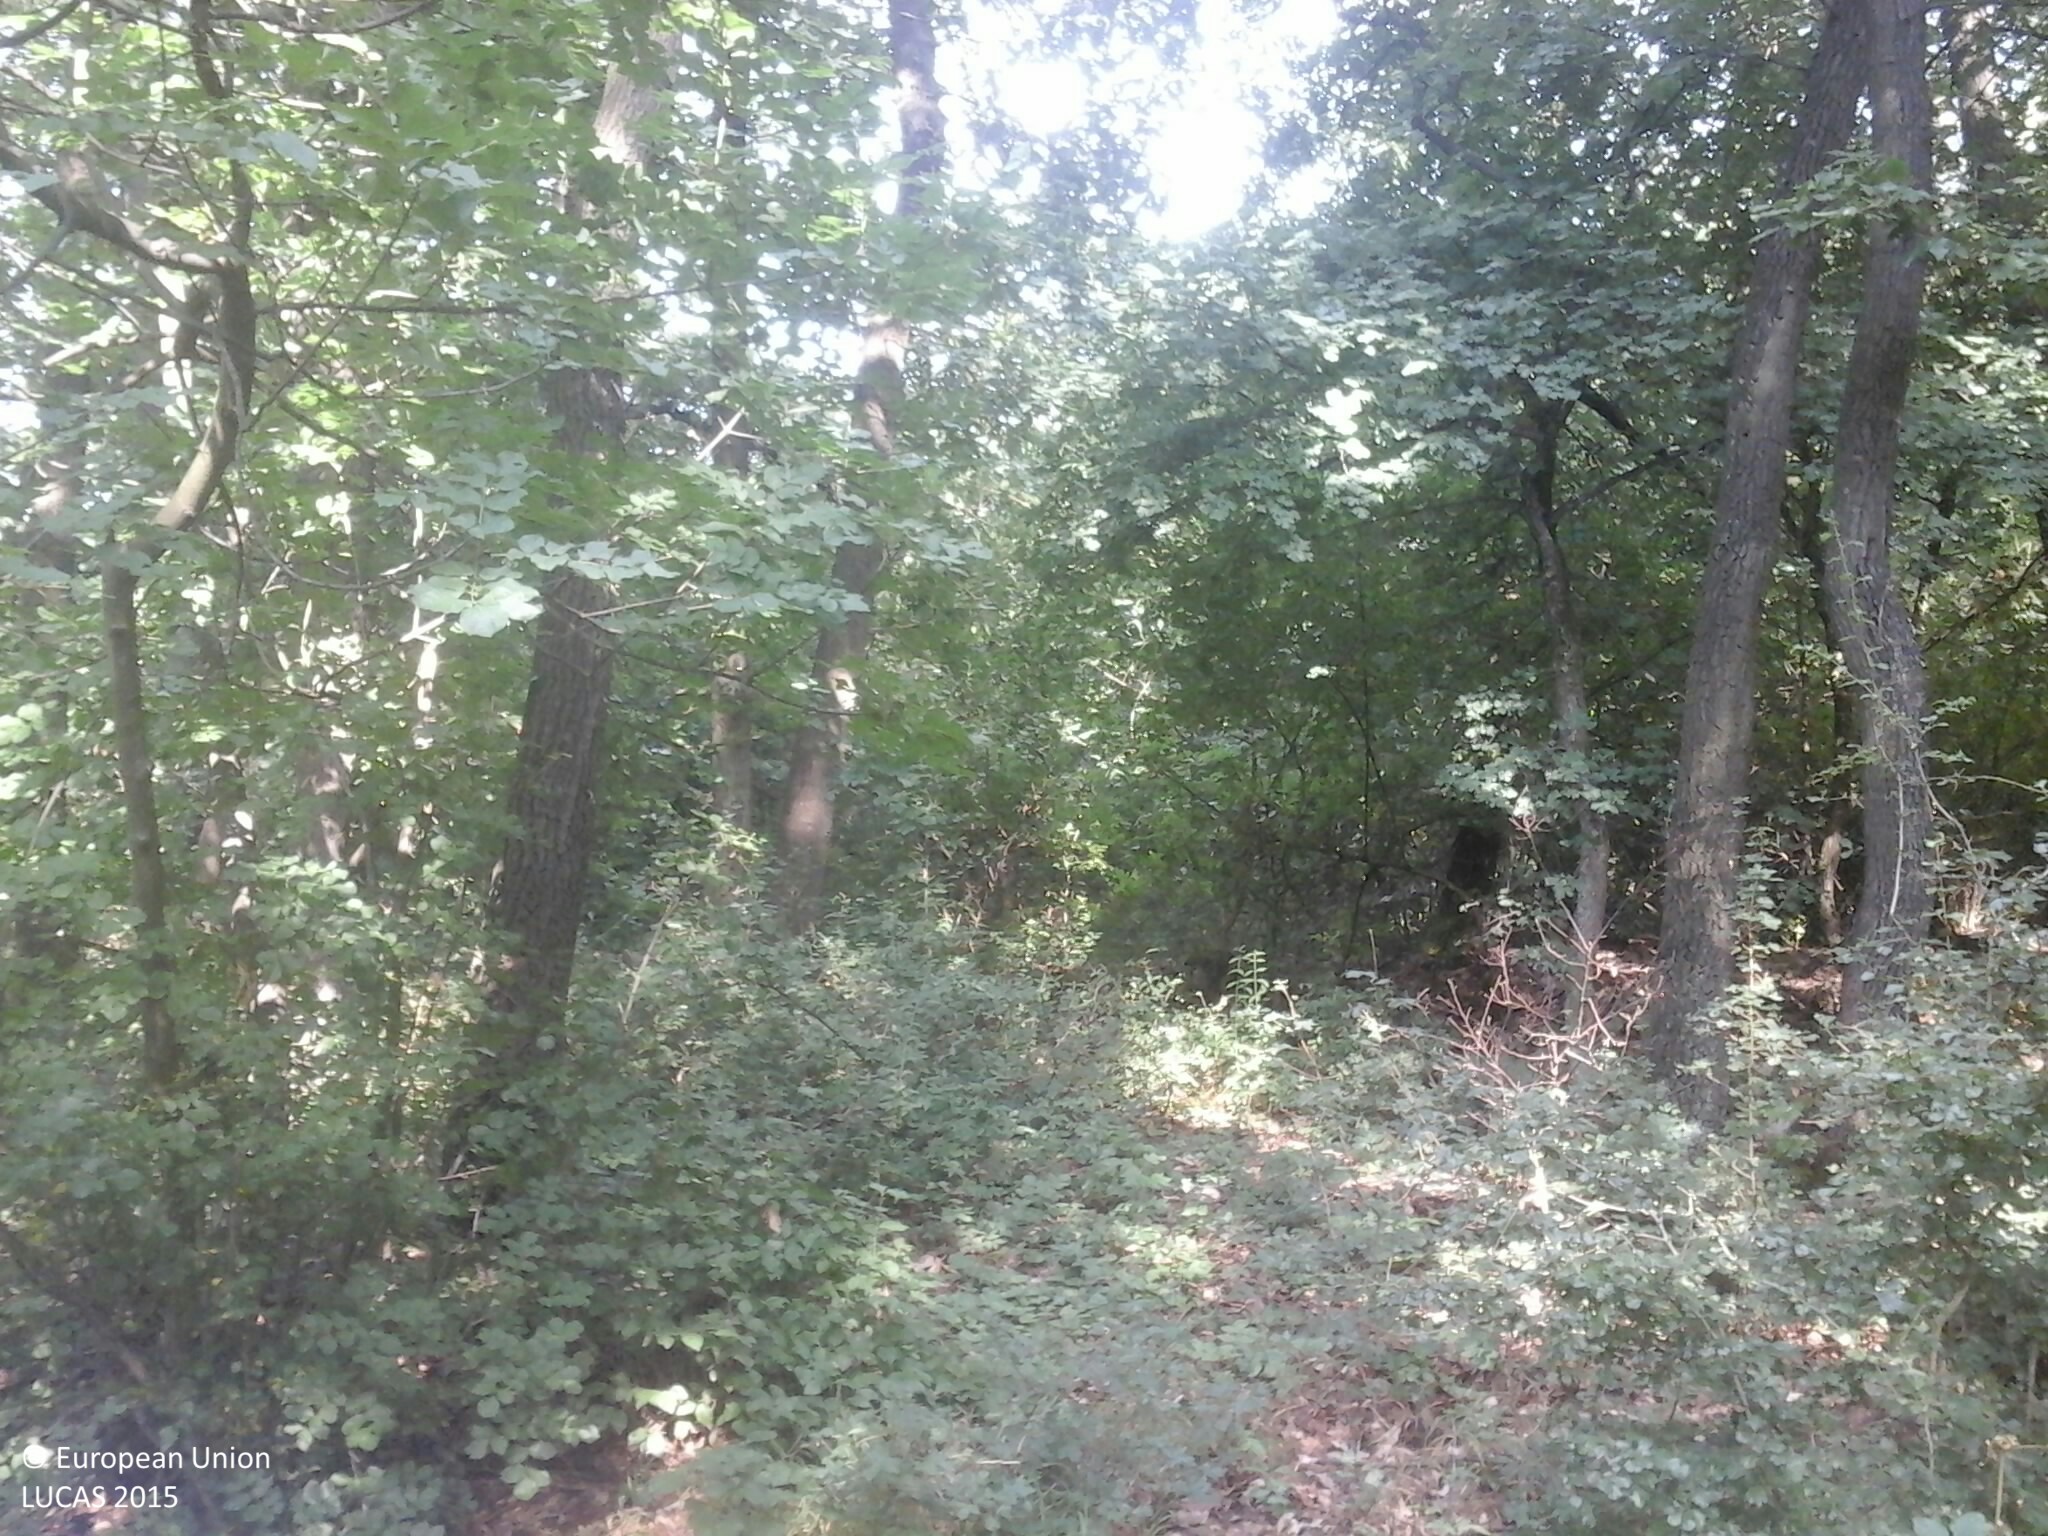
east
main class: Woodland
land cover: Broadleaved woodland
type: acidophilous oak and oak-birch forest
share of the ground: > 75 %
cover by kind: broadleaved forest trees 95 %, shrubs 5 %
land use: Forestry
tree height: > 5 m
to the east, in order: Broadleaved woodland; Grassland without tree/shrub cover; Broadleaved woodland; Tracks; Broadleaved woodland
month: July
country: HU
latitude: 46.9186
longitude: 17.7682
